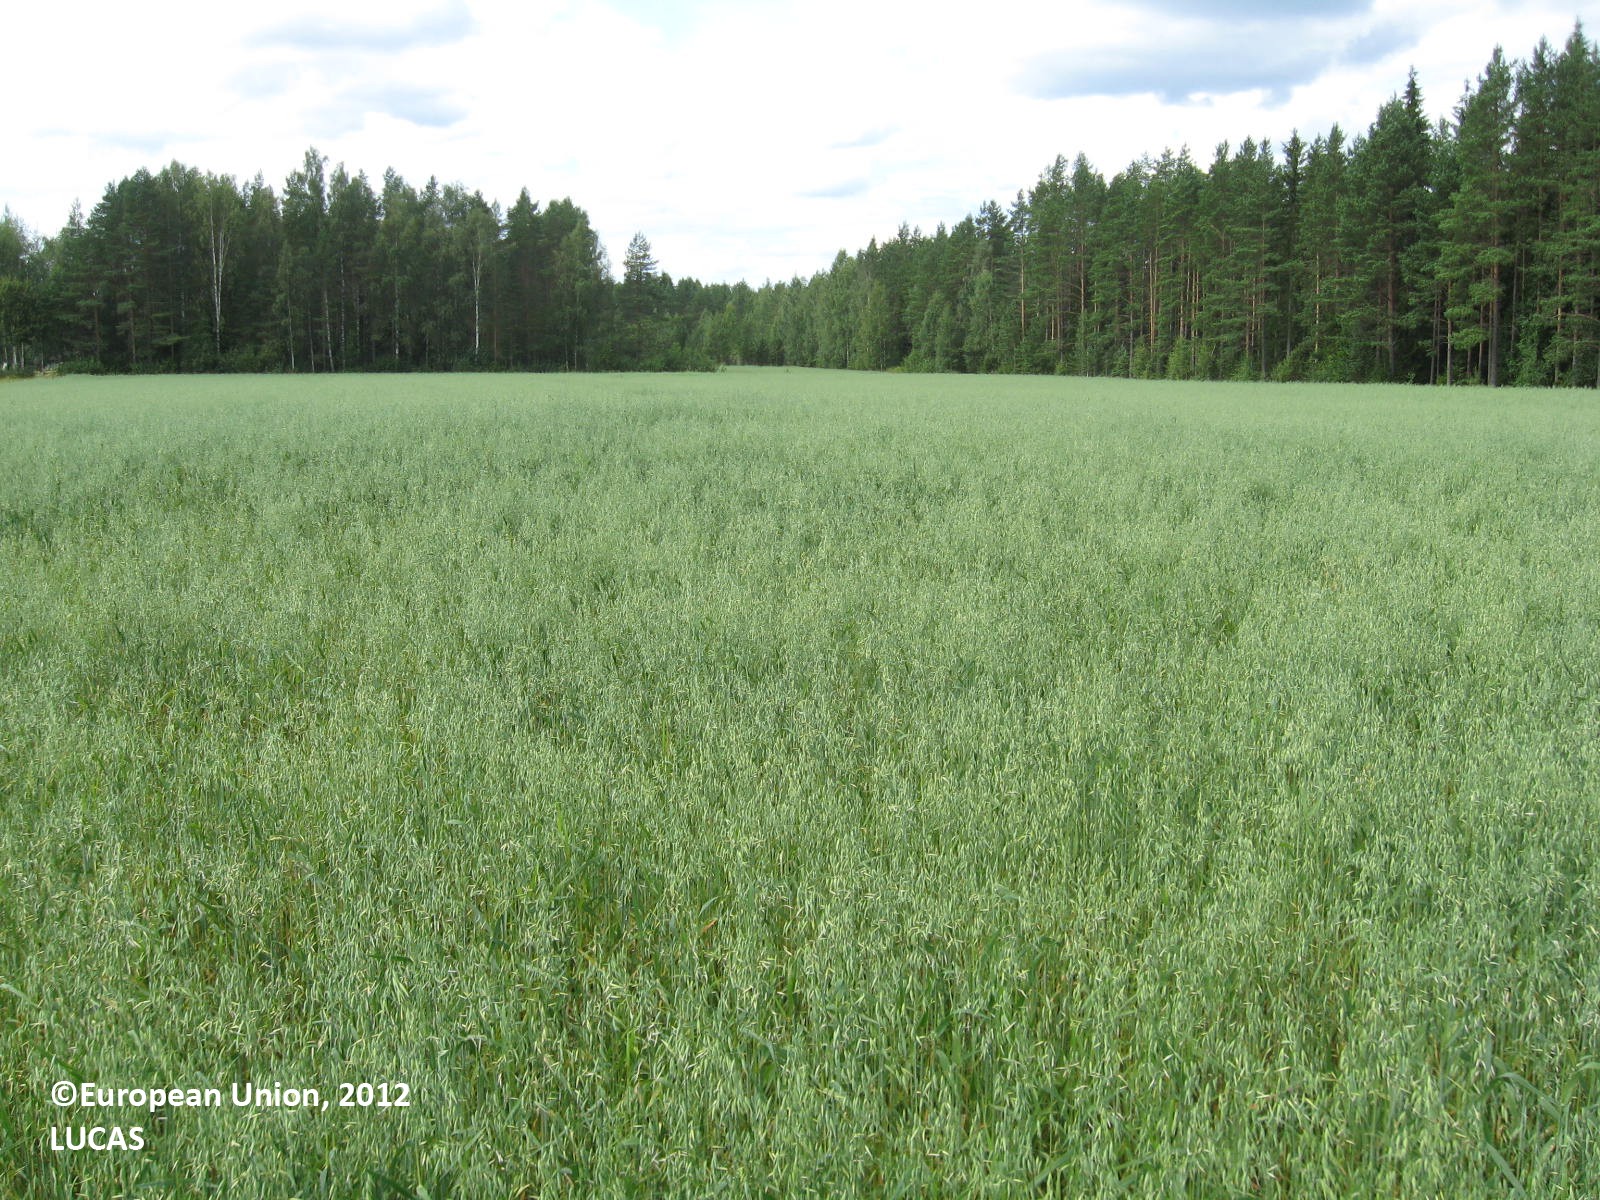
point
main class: Cropland
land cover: Oats
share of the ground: > 75 %
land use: Agriculture (excluding fallow land and kitchen gardens)
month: July
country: FI
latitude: 62.0206
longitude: 22.2267
